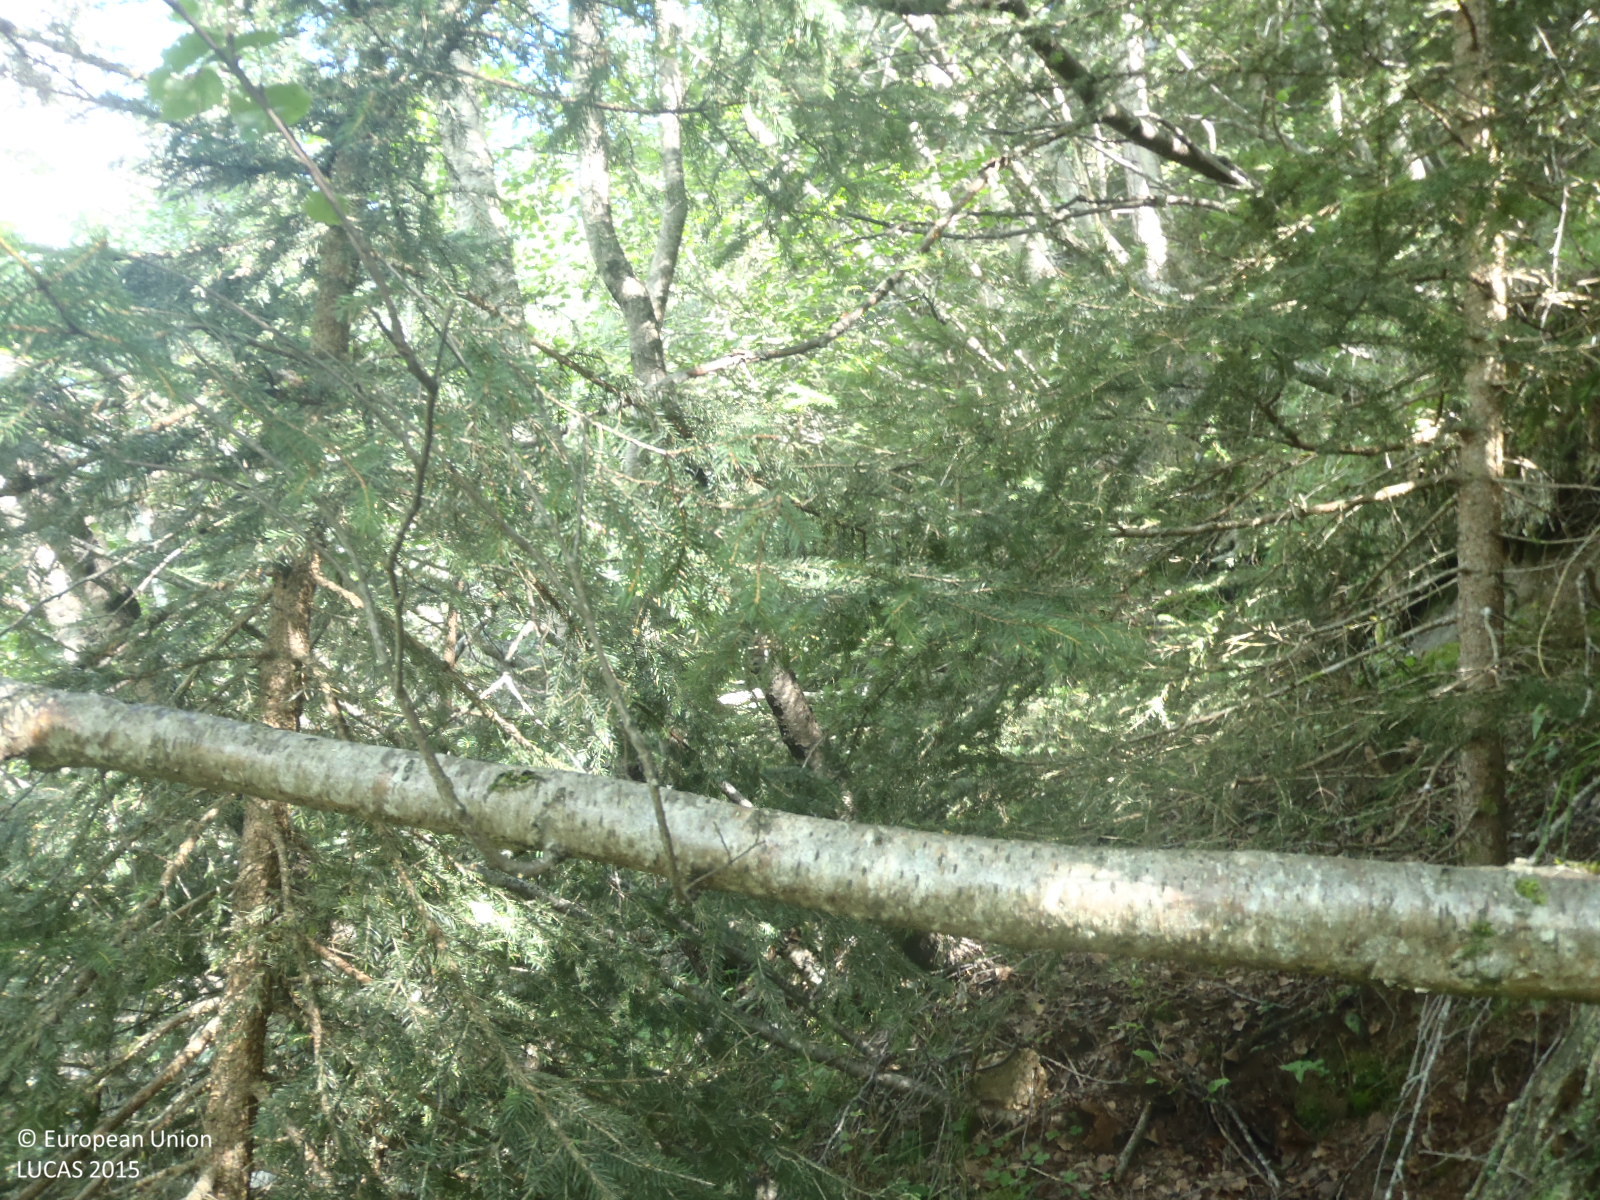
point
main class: Woodland
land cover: Broadleaved woodland
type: mesophytic deciduous forest
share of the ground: > 75 %
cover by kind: broadleaved forest trees 90 %, coniferous forest trees 10 %
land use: Semi-natural and natural areas not in use
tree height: > 5 m
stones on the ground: < 10 %
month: August
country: AT
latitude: 47.0105
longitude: 12.3261
